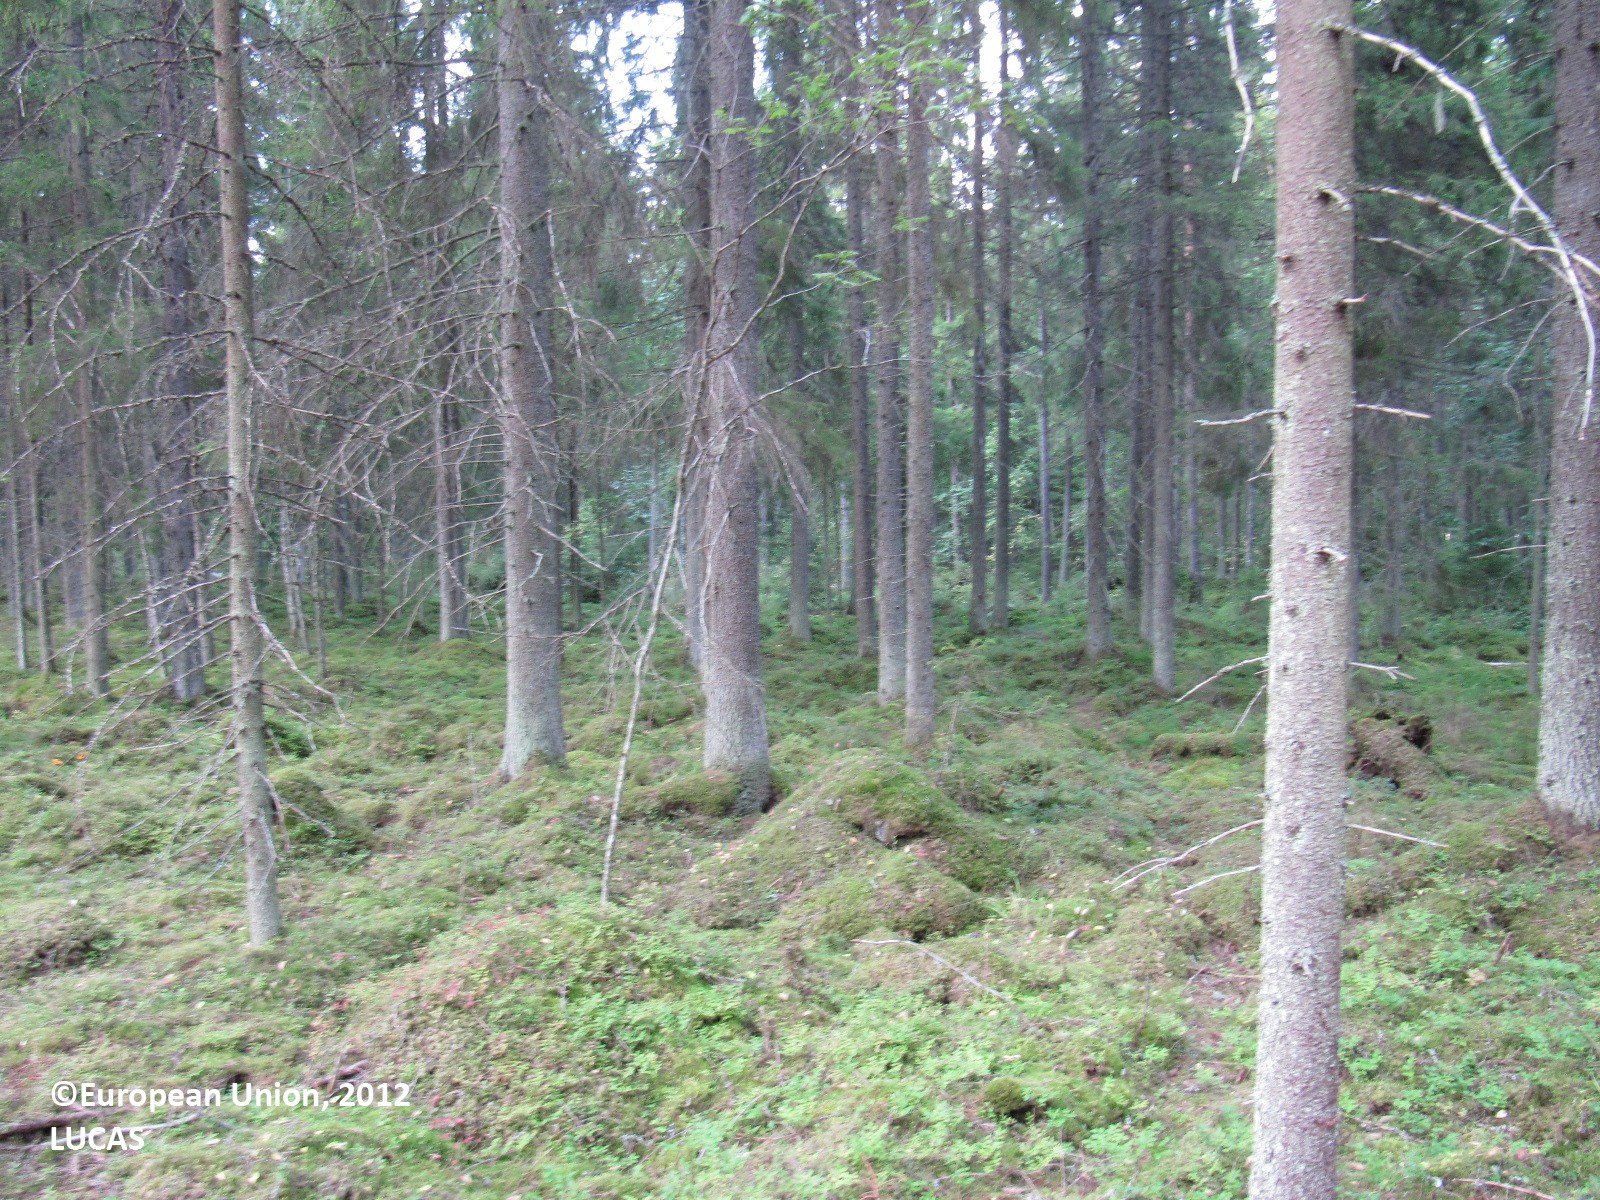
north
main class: Woodland
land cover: Spruce dominated coniferous woodland
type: boreal forest
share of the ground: > 75 %
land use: Forestry
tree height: > 5 m
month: August
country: FI
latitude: 61.0506
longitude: 22.8697
